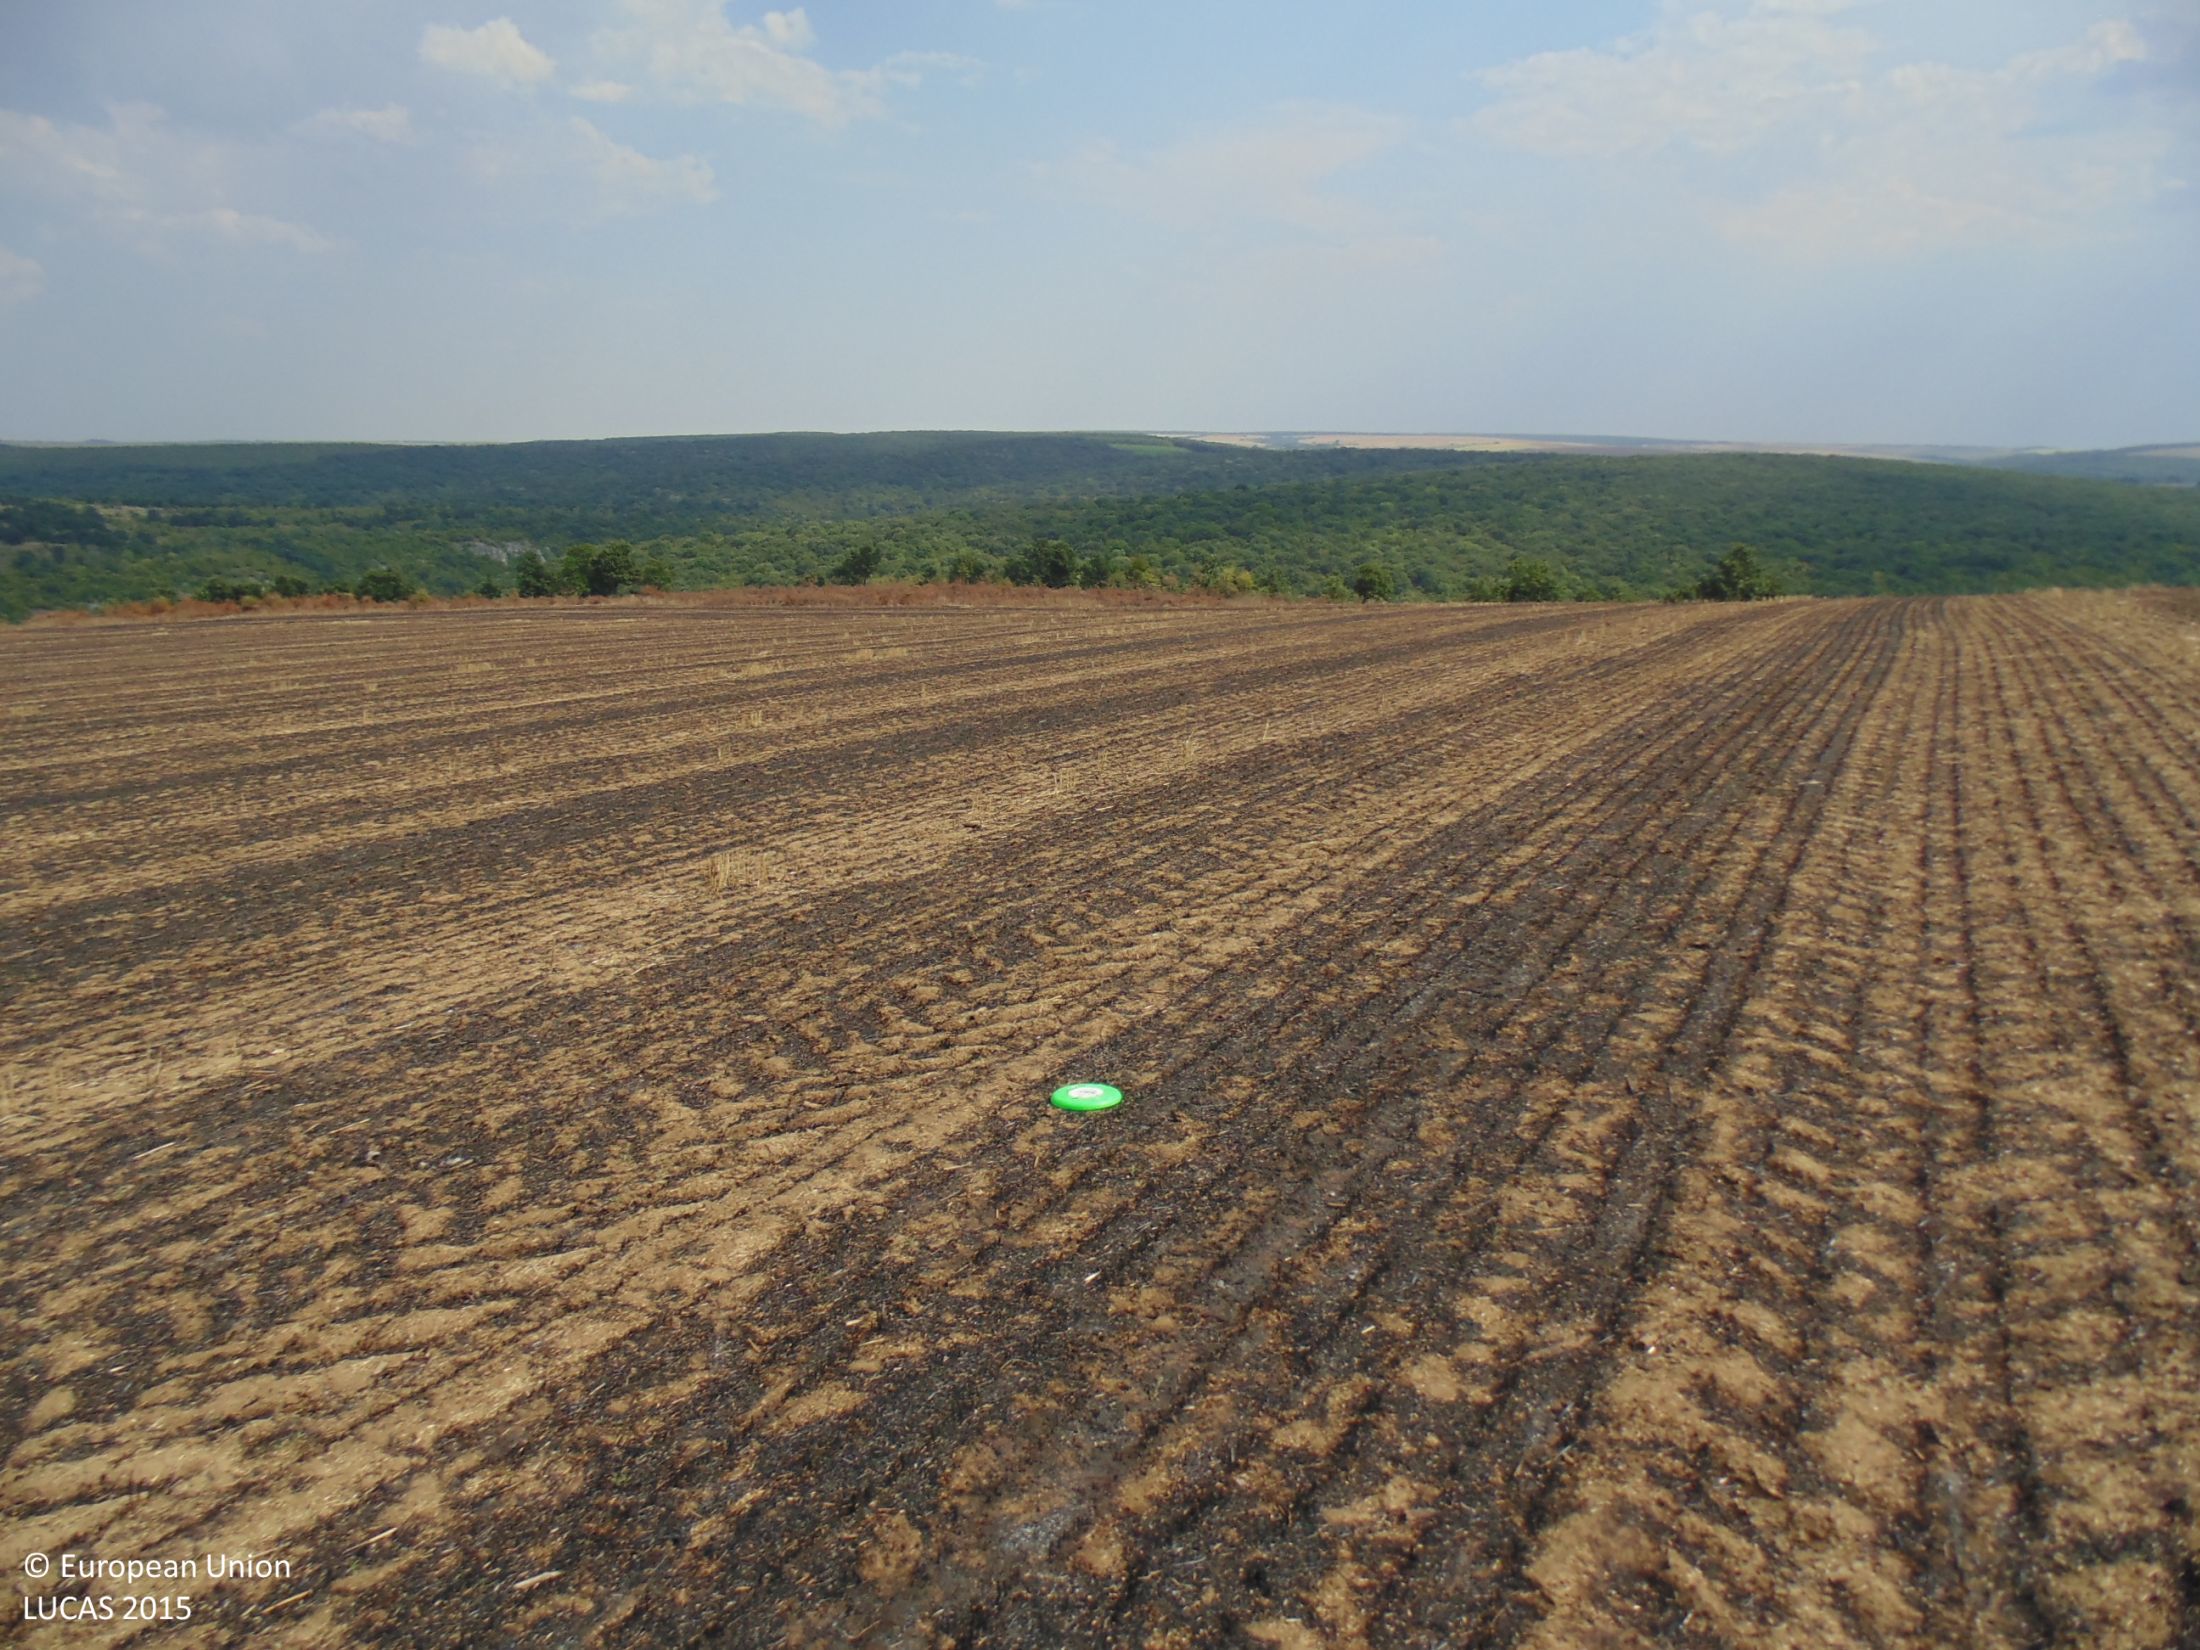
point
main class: Cropland
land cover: Common wheat
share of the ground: < 10 %
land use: Agriculture (excluding fallow land and kitchen gardens)
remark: Burnt area
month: August
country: BG
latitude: 43.9344
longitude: 27.6171
